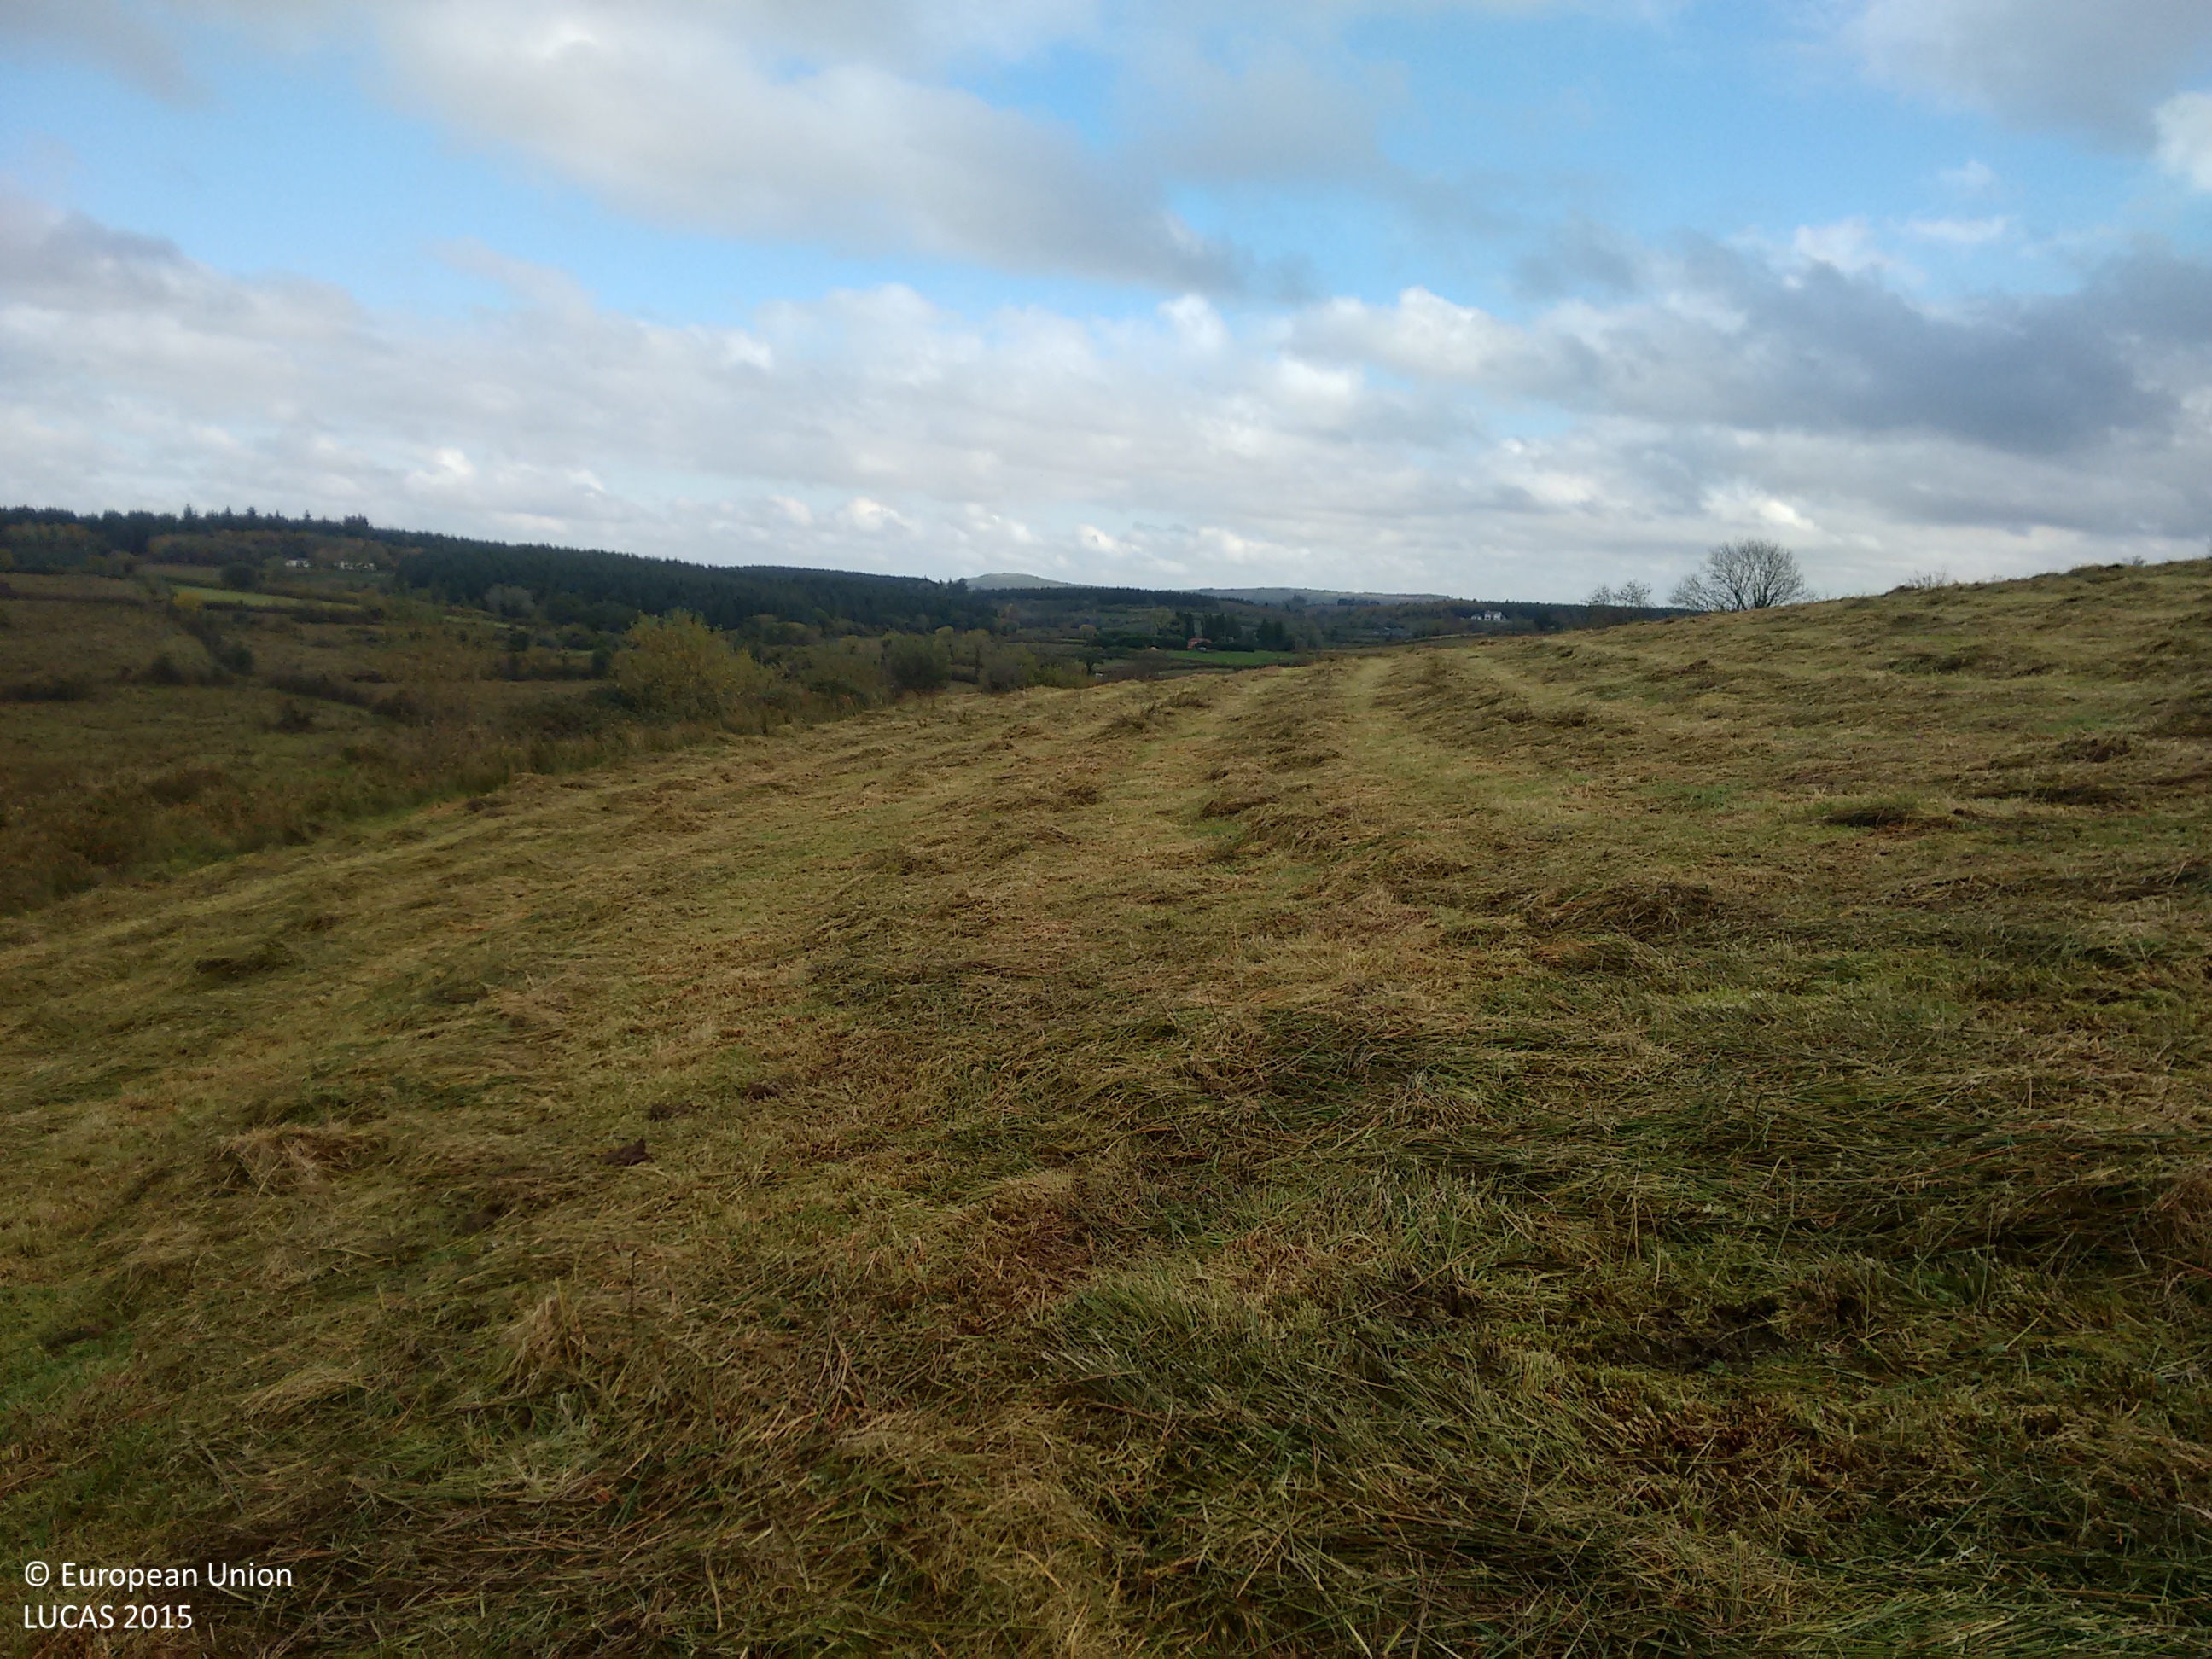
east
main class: Grassland
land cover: Grassland without tree/shrub cover
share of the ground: > 75 %
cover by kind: herbaceous plants 100 %
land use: Agriculture (excluding fallow land and kitchen gardens)
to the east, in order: Grassland without tree/shrub cover; Ditches and canals; Abandoned hedges; Grassland without tree/shrub cover; Fences; Ditches and canals; Abandoned hedges; Fences; Ditches and canals; Grassland without tree/shrub cover
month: October
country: IE
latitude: 53.9917
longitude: -8.1312
